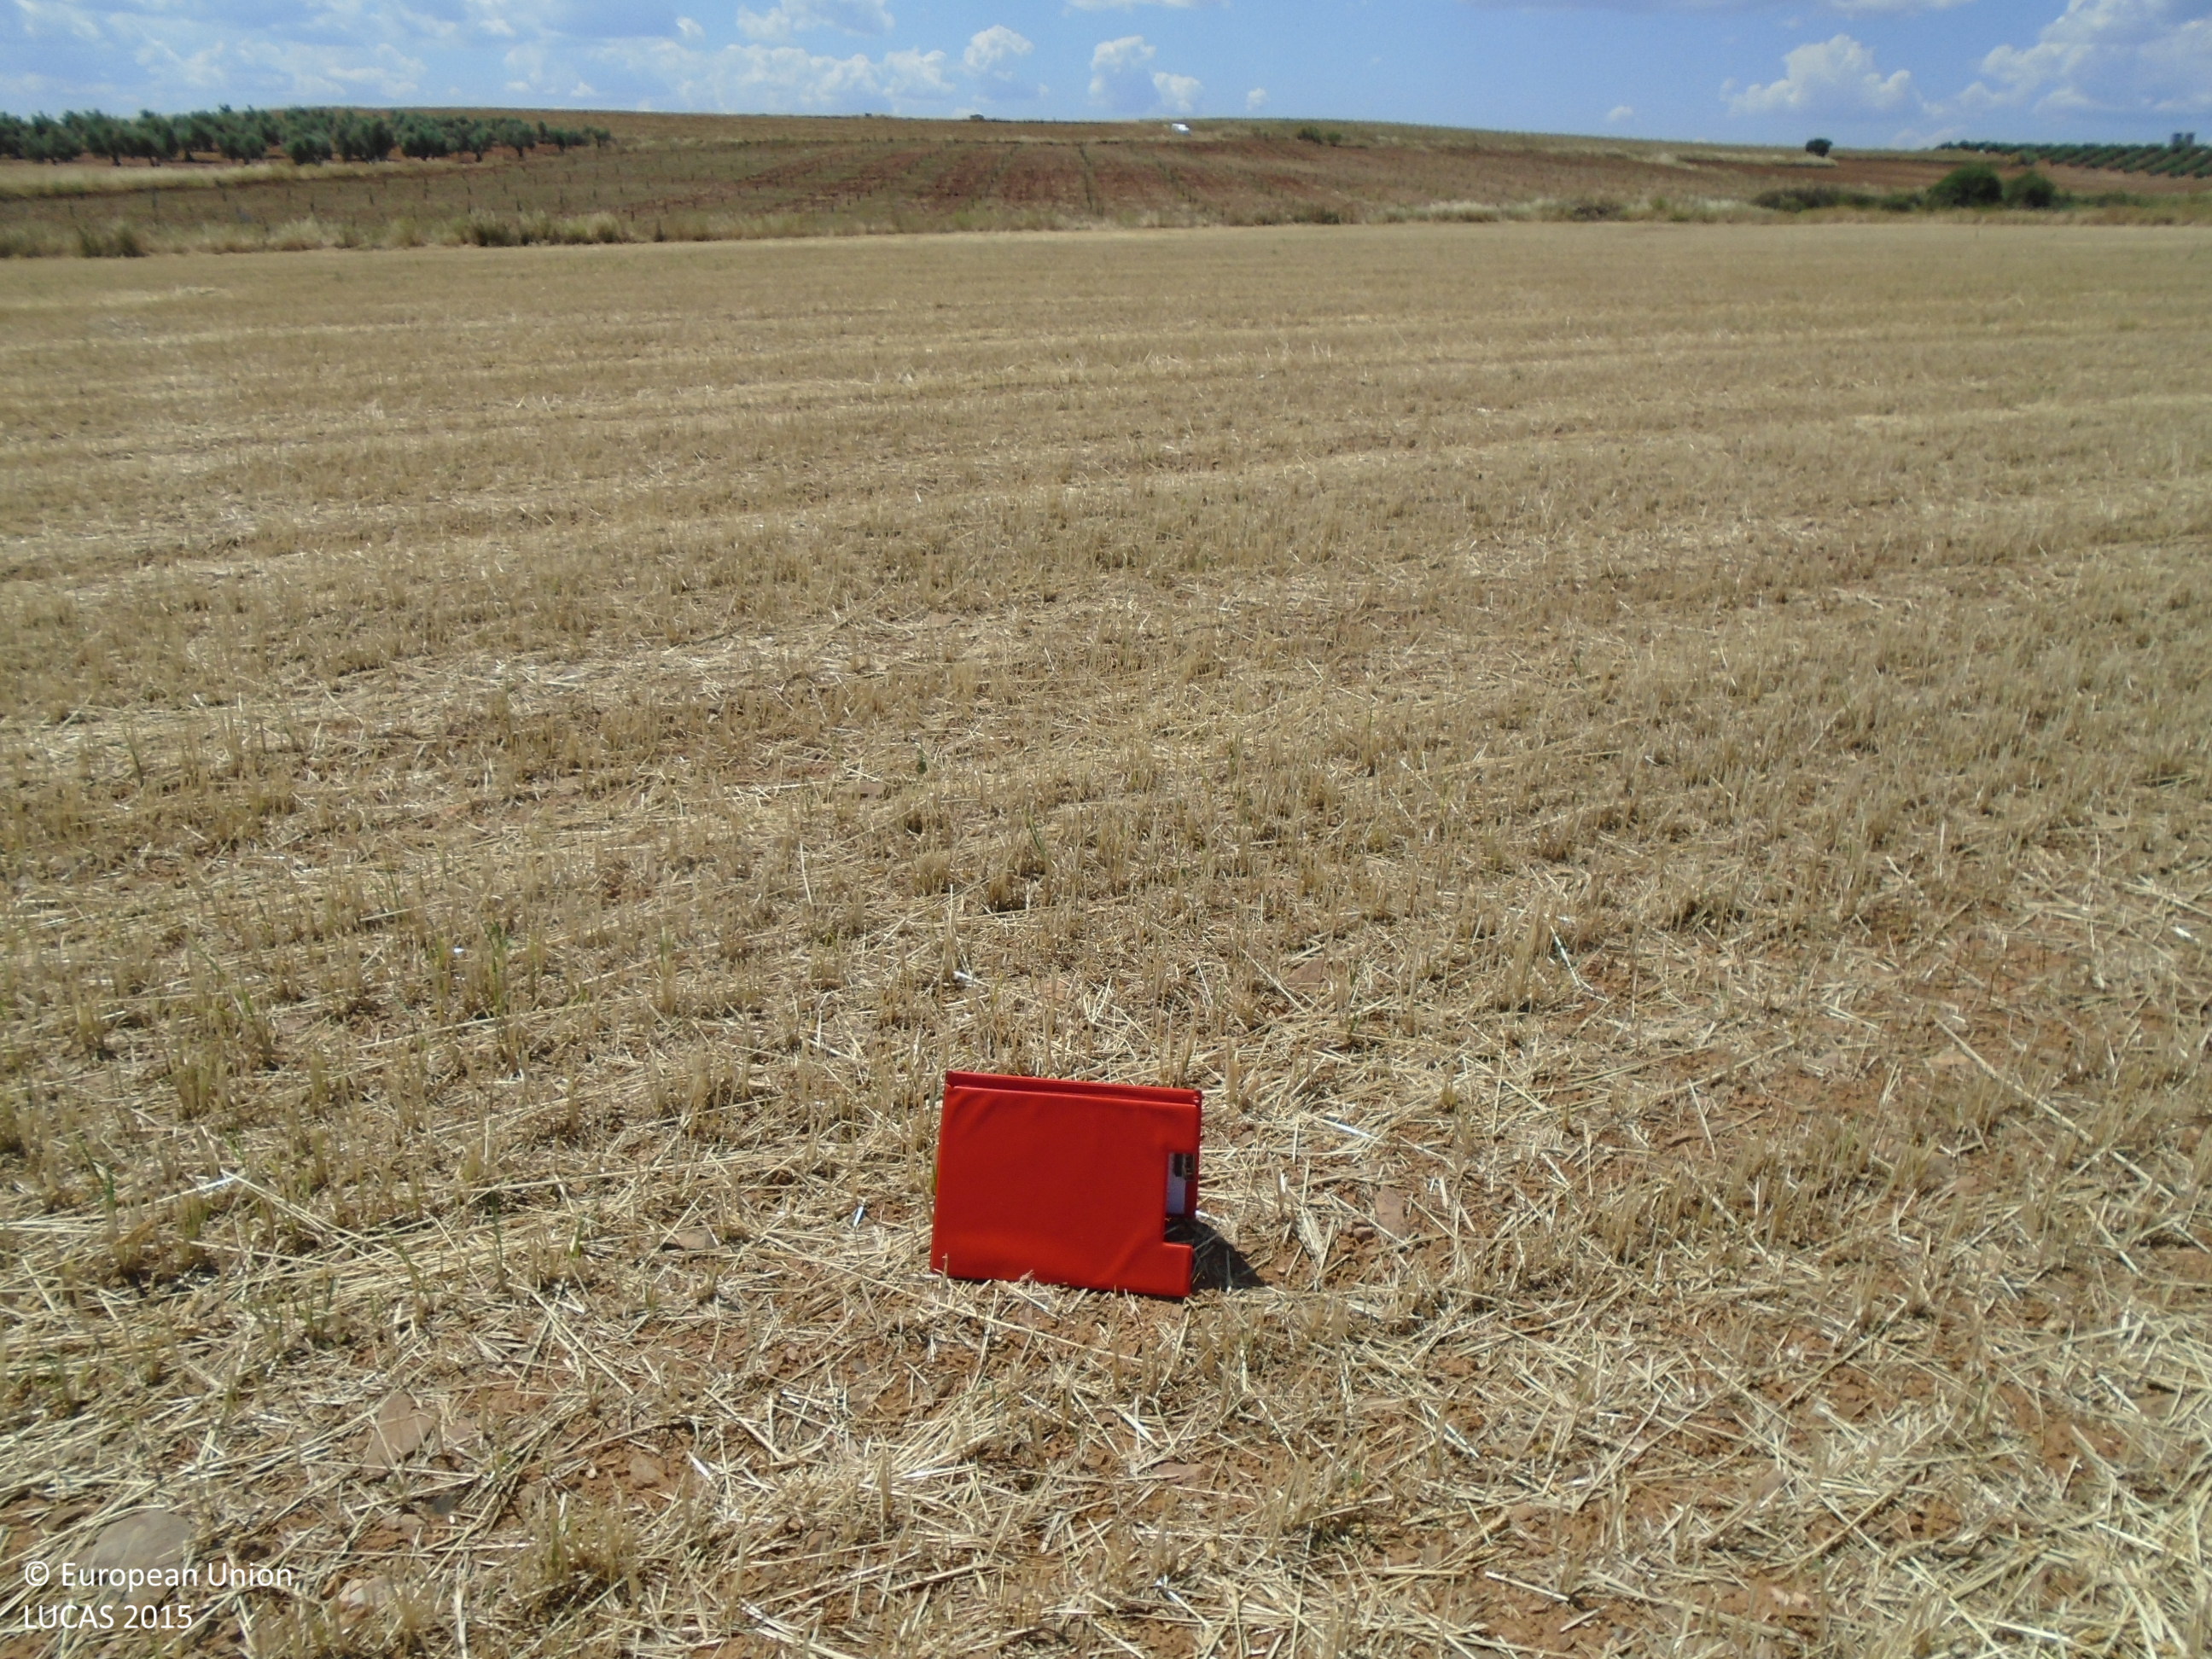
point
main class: Cropland
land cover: Barley
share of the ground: > 75 %
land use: Agriculture (excluding fallow land and kitchen gardens)
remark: Harvested field
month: June
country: ES
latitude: 39.6903
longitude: -4.1786
